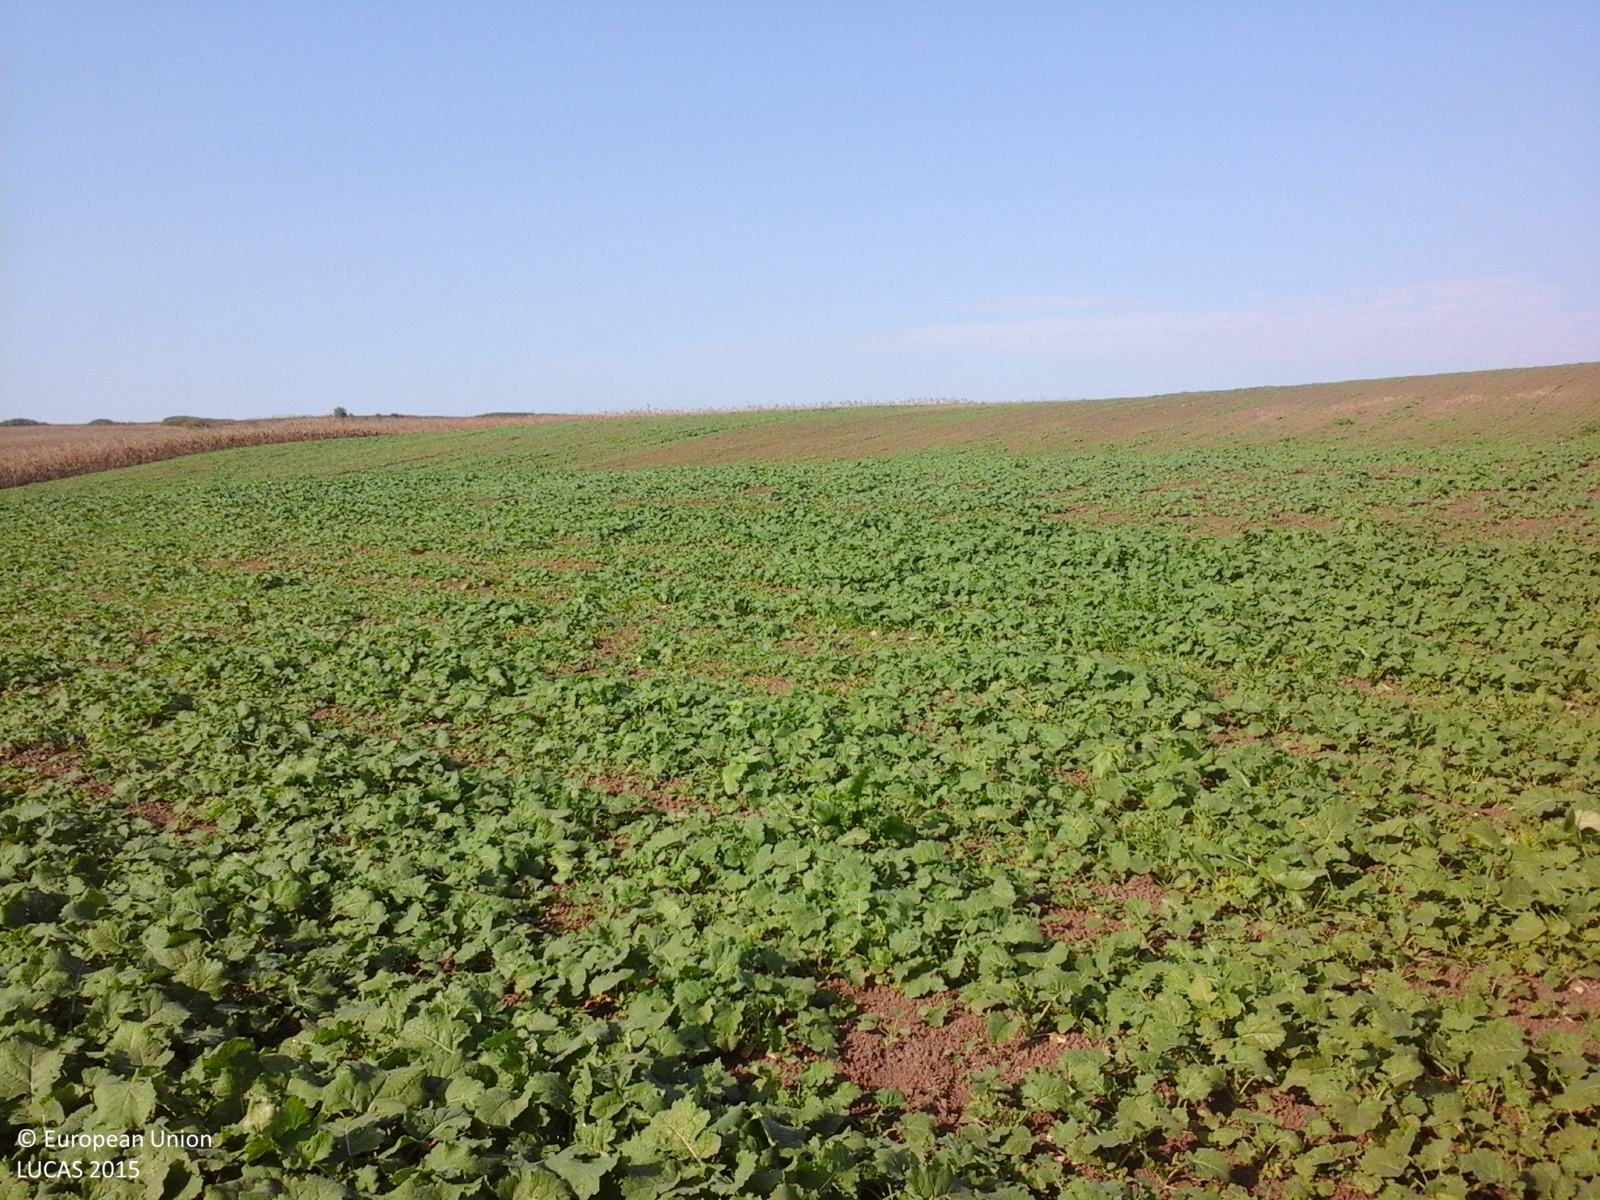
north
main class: Cropland
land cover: Rape and turnip rape
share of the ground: > 75 %
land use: Agriculture (excluding fallow land and kitchen gardens)
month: October
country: RO
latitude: 46.5133
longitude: 24.1960
